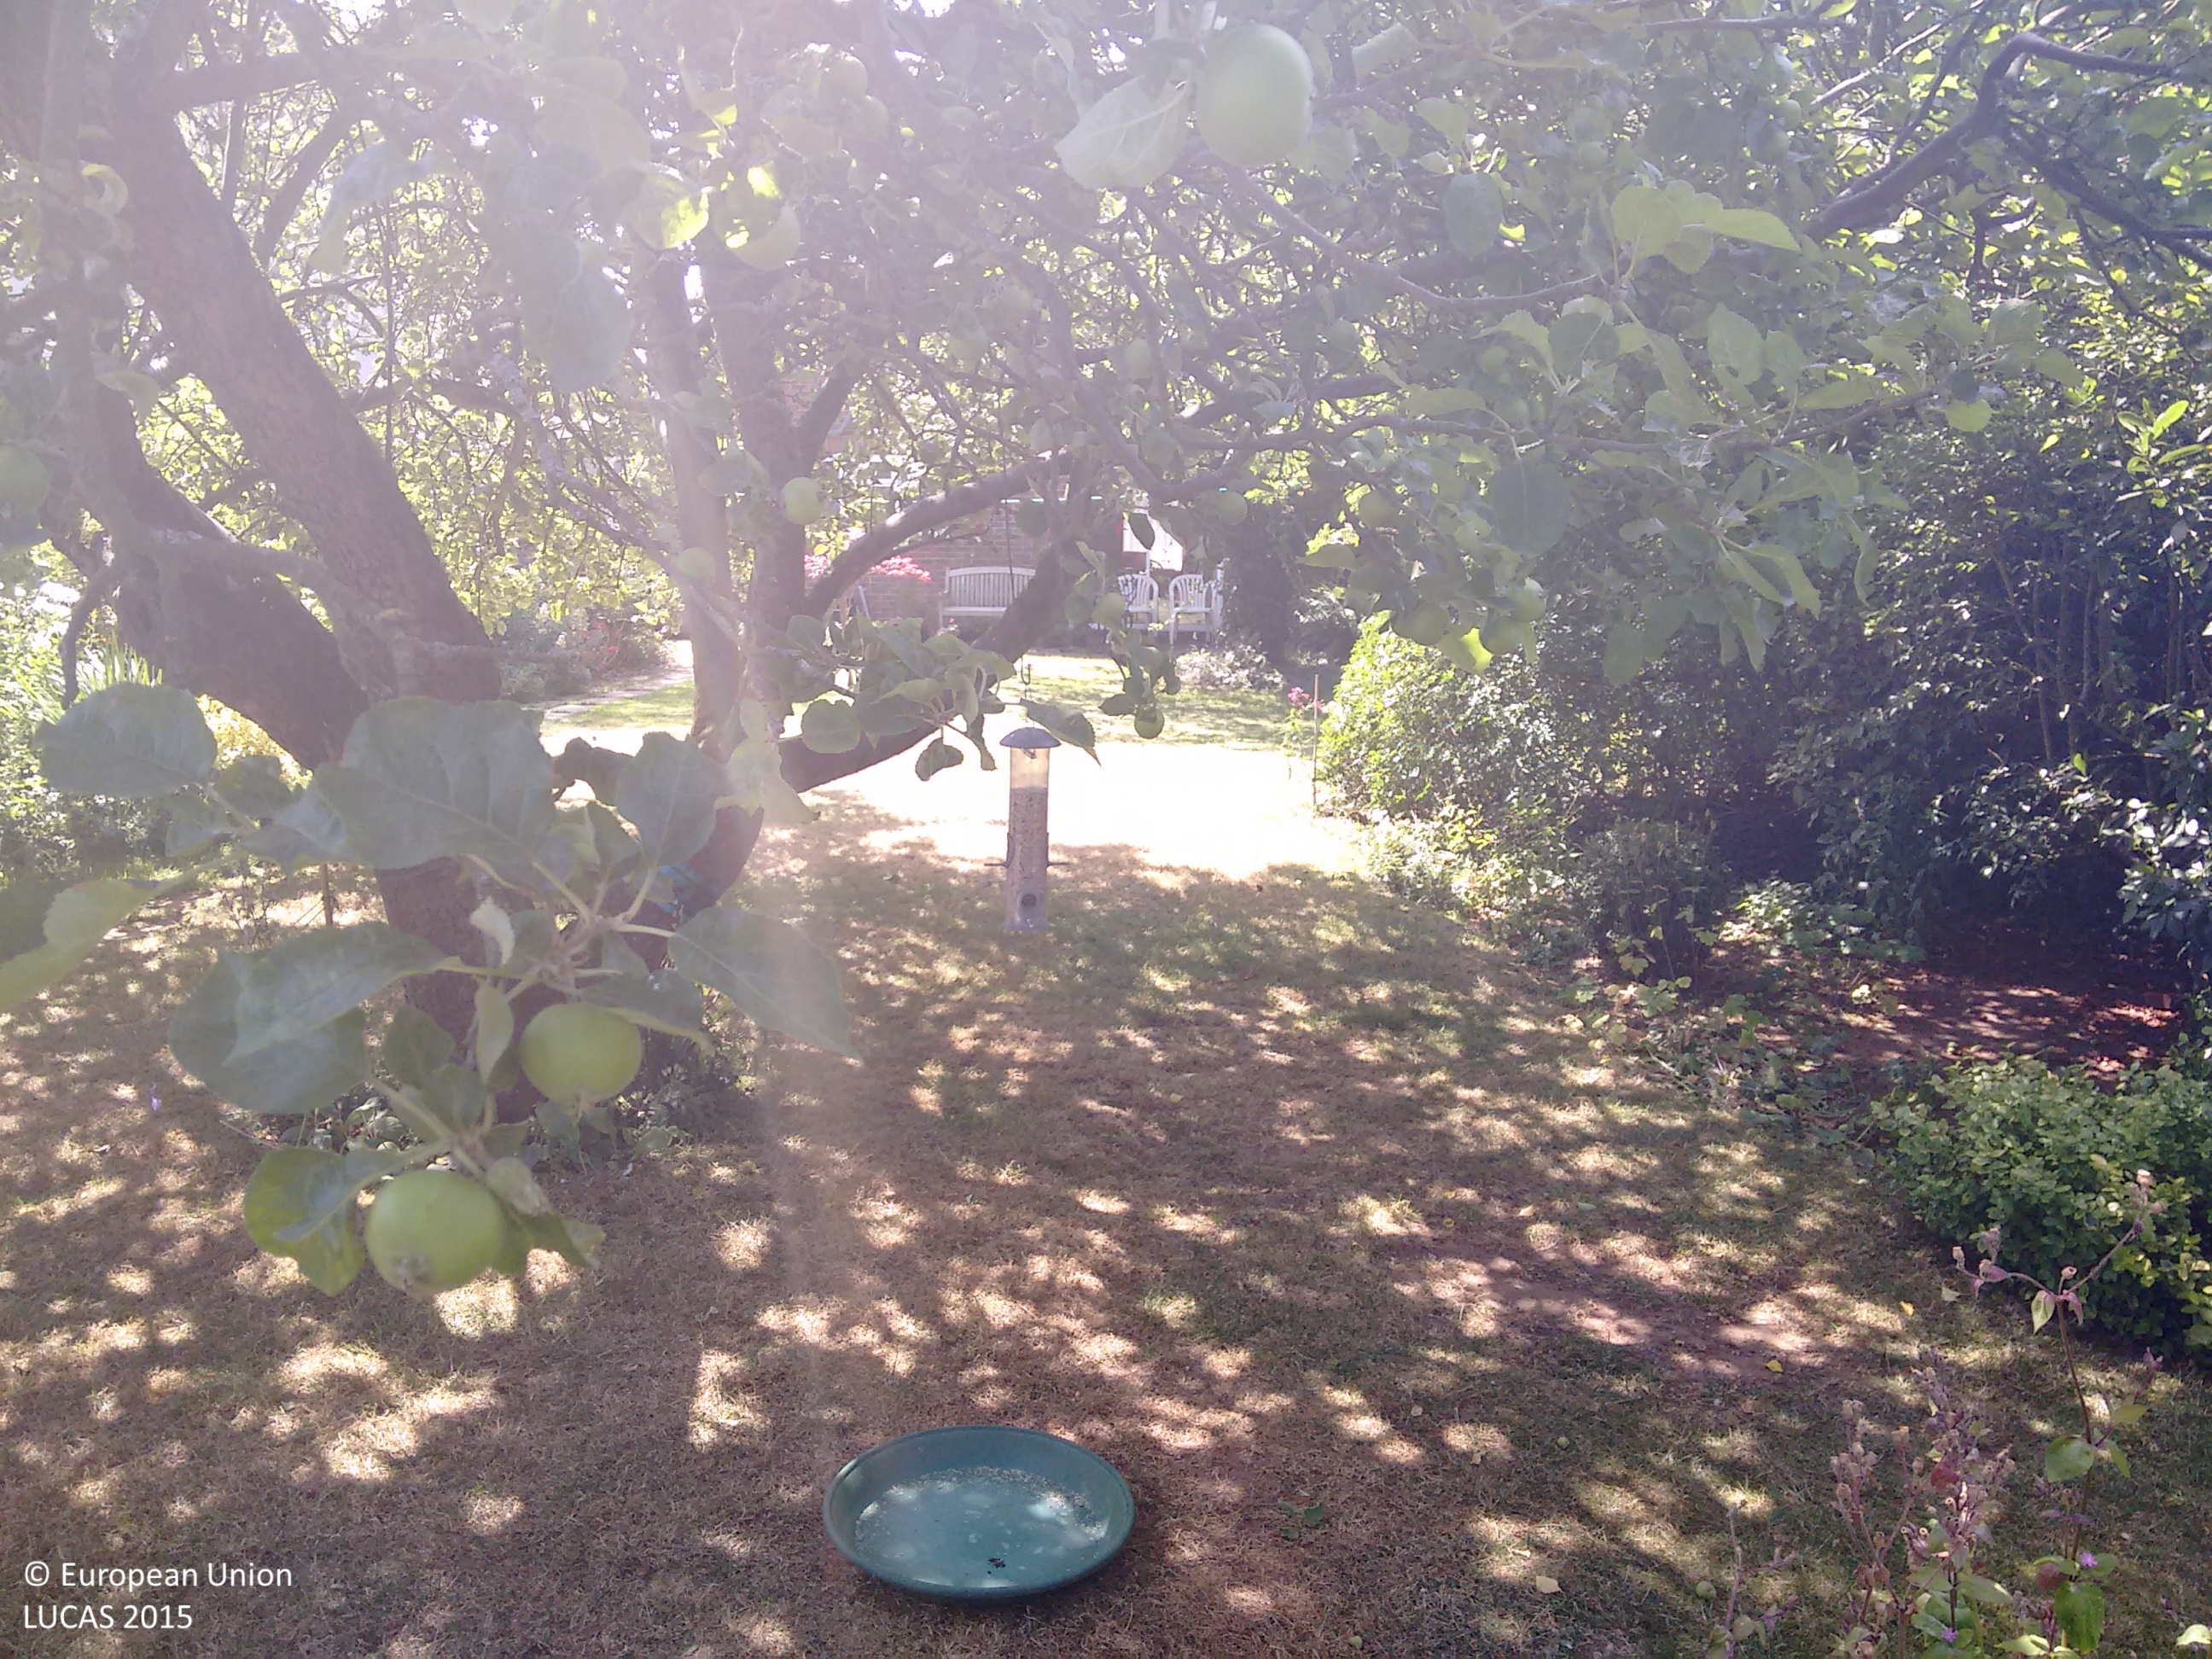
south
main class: Woodland
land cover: Broadleaved woodland
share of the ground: > 75 %
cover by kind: broadleaved forest trees 100 %
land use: Residential
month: July
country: GB
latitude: 51.1750
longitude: -0.6101
